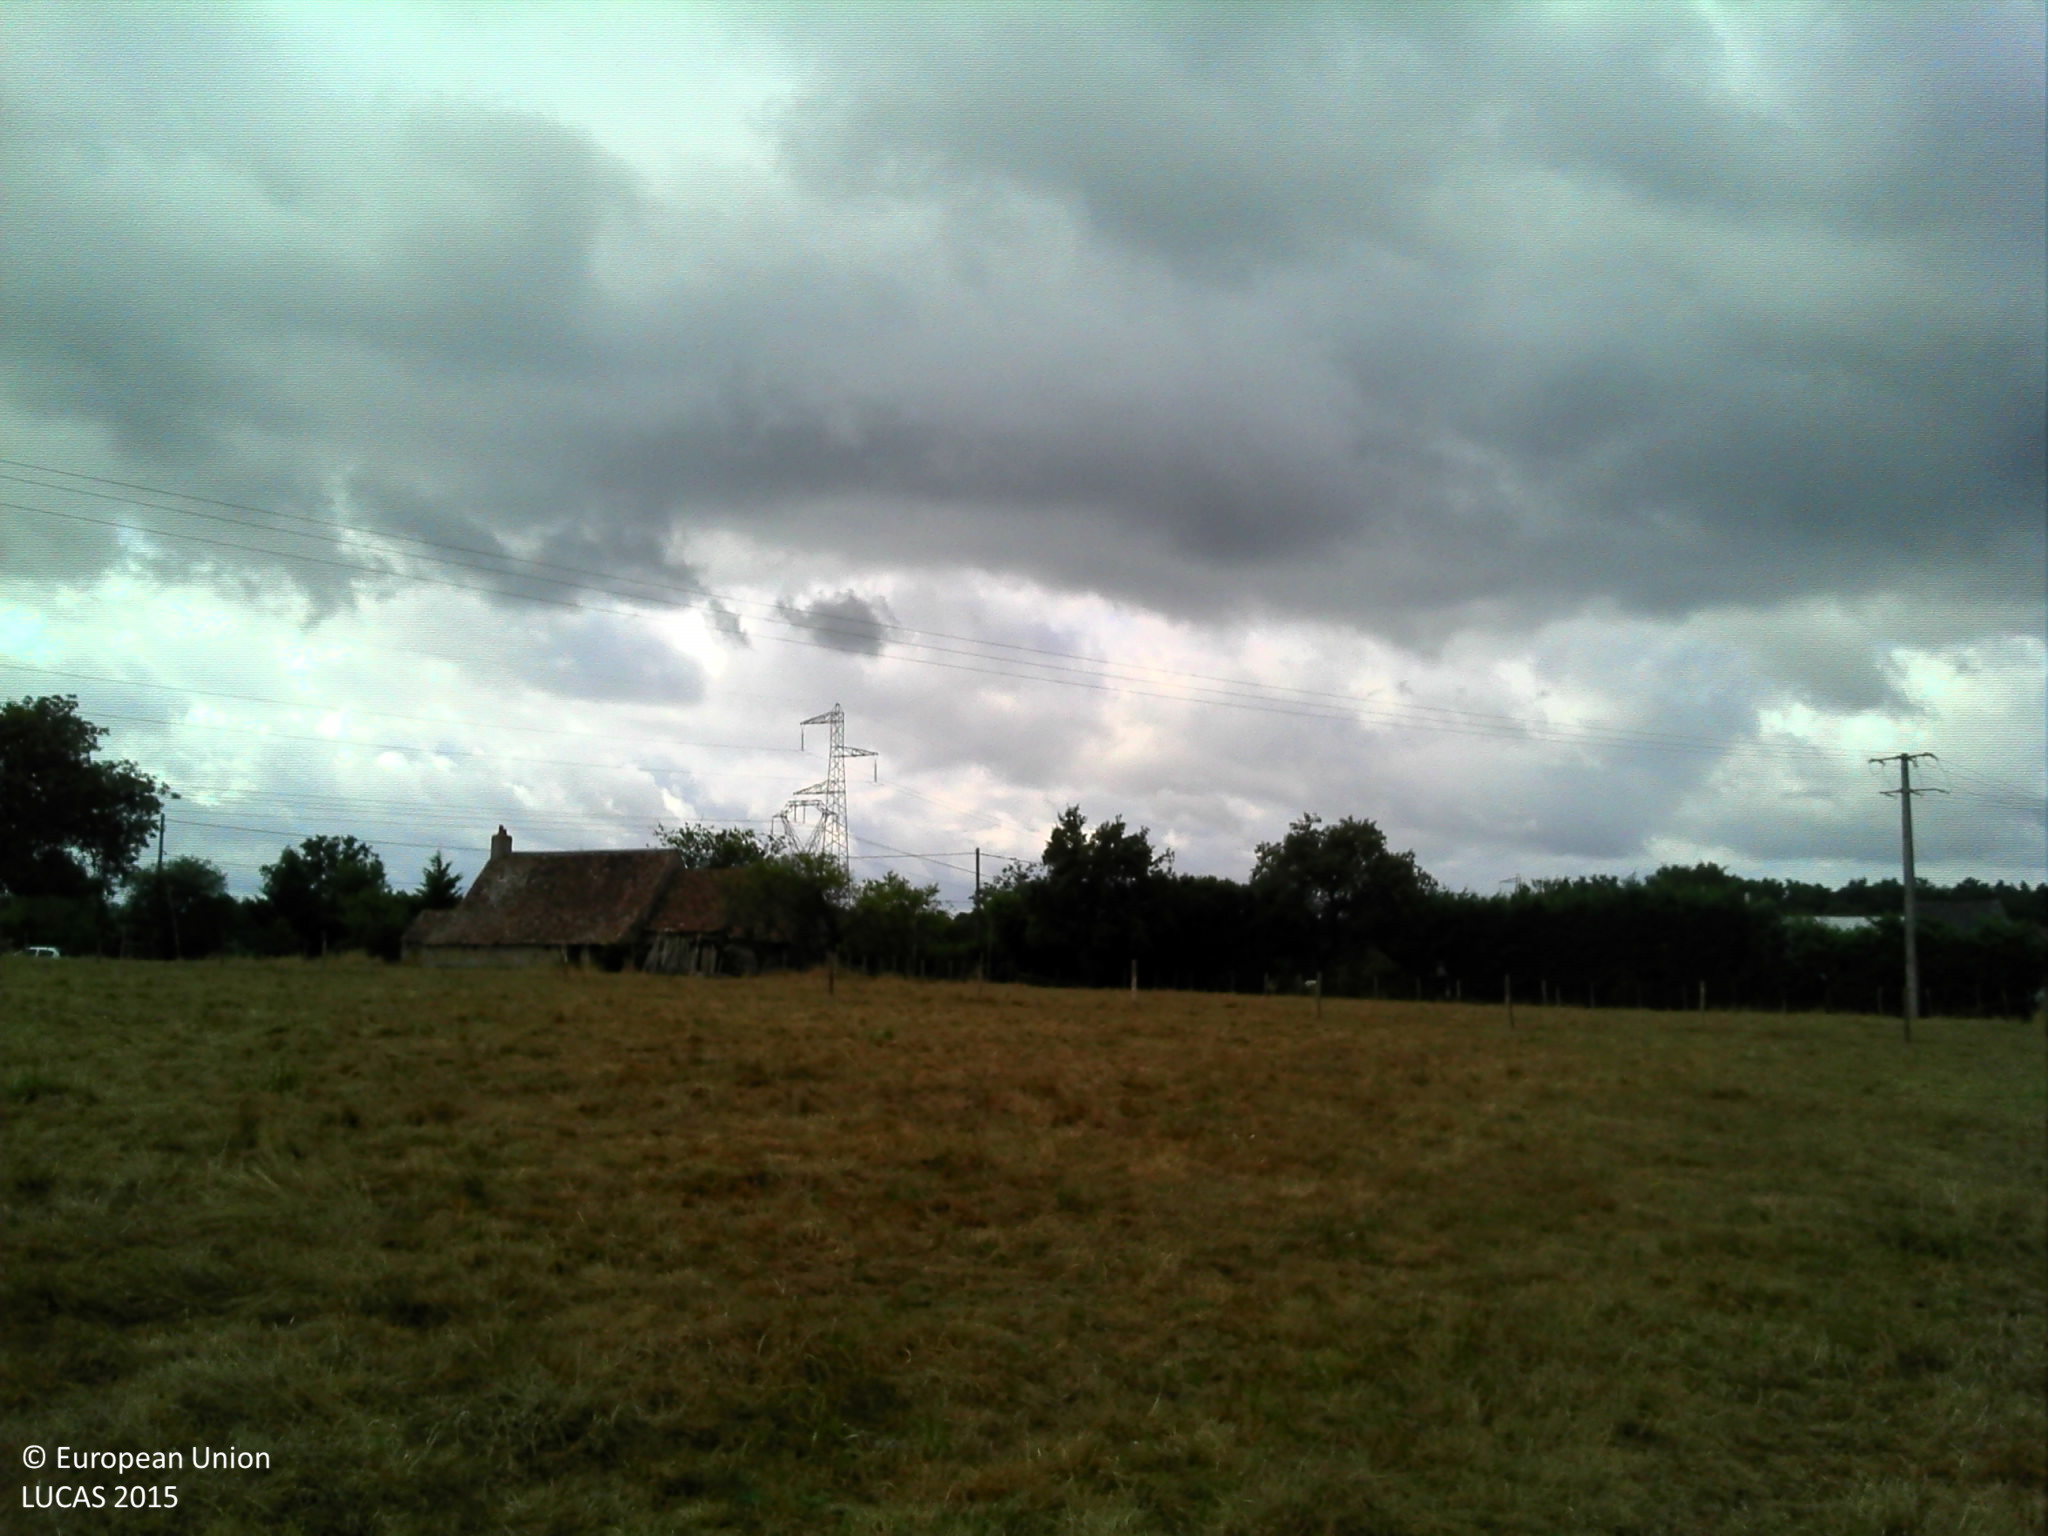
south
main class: Grassland
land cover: Grassland without tree/shrub cover
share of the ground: > 75 %
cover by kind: herbaceous plants 100 %
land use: Agriculture (excluding fallow land and kitchen gardens)
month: July
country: FR
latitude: 47.8077
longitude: 0.2406
